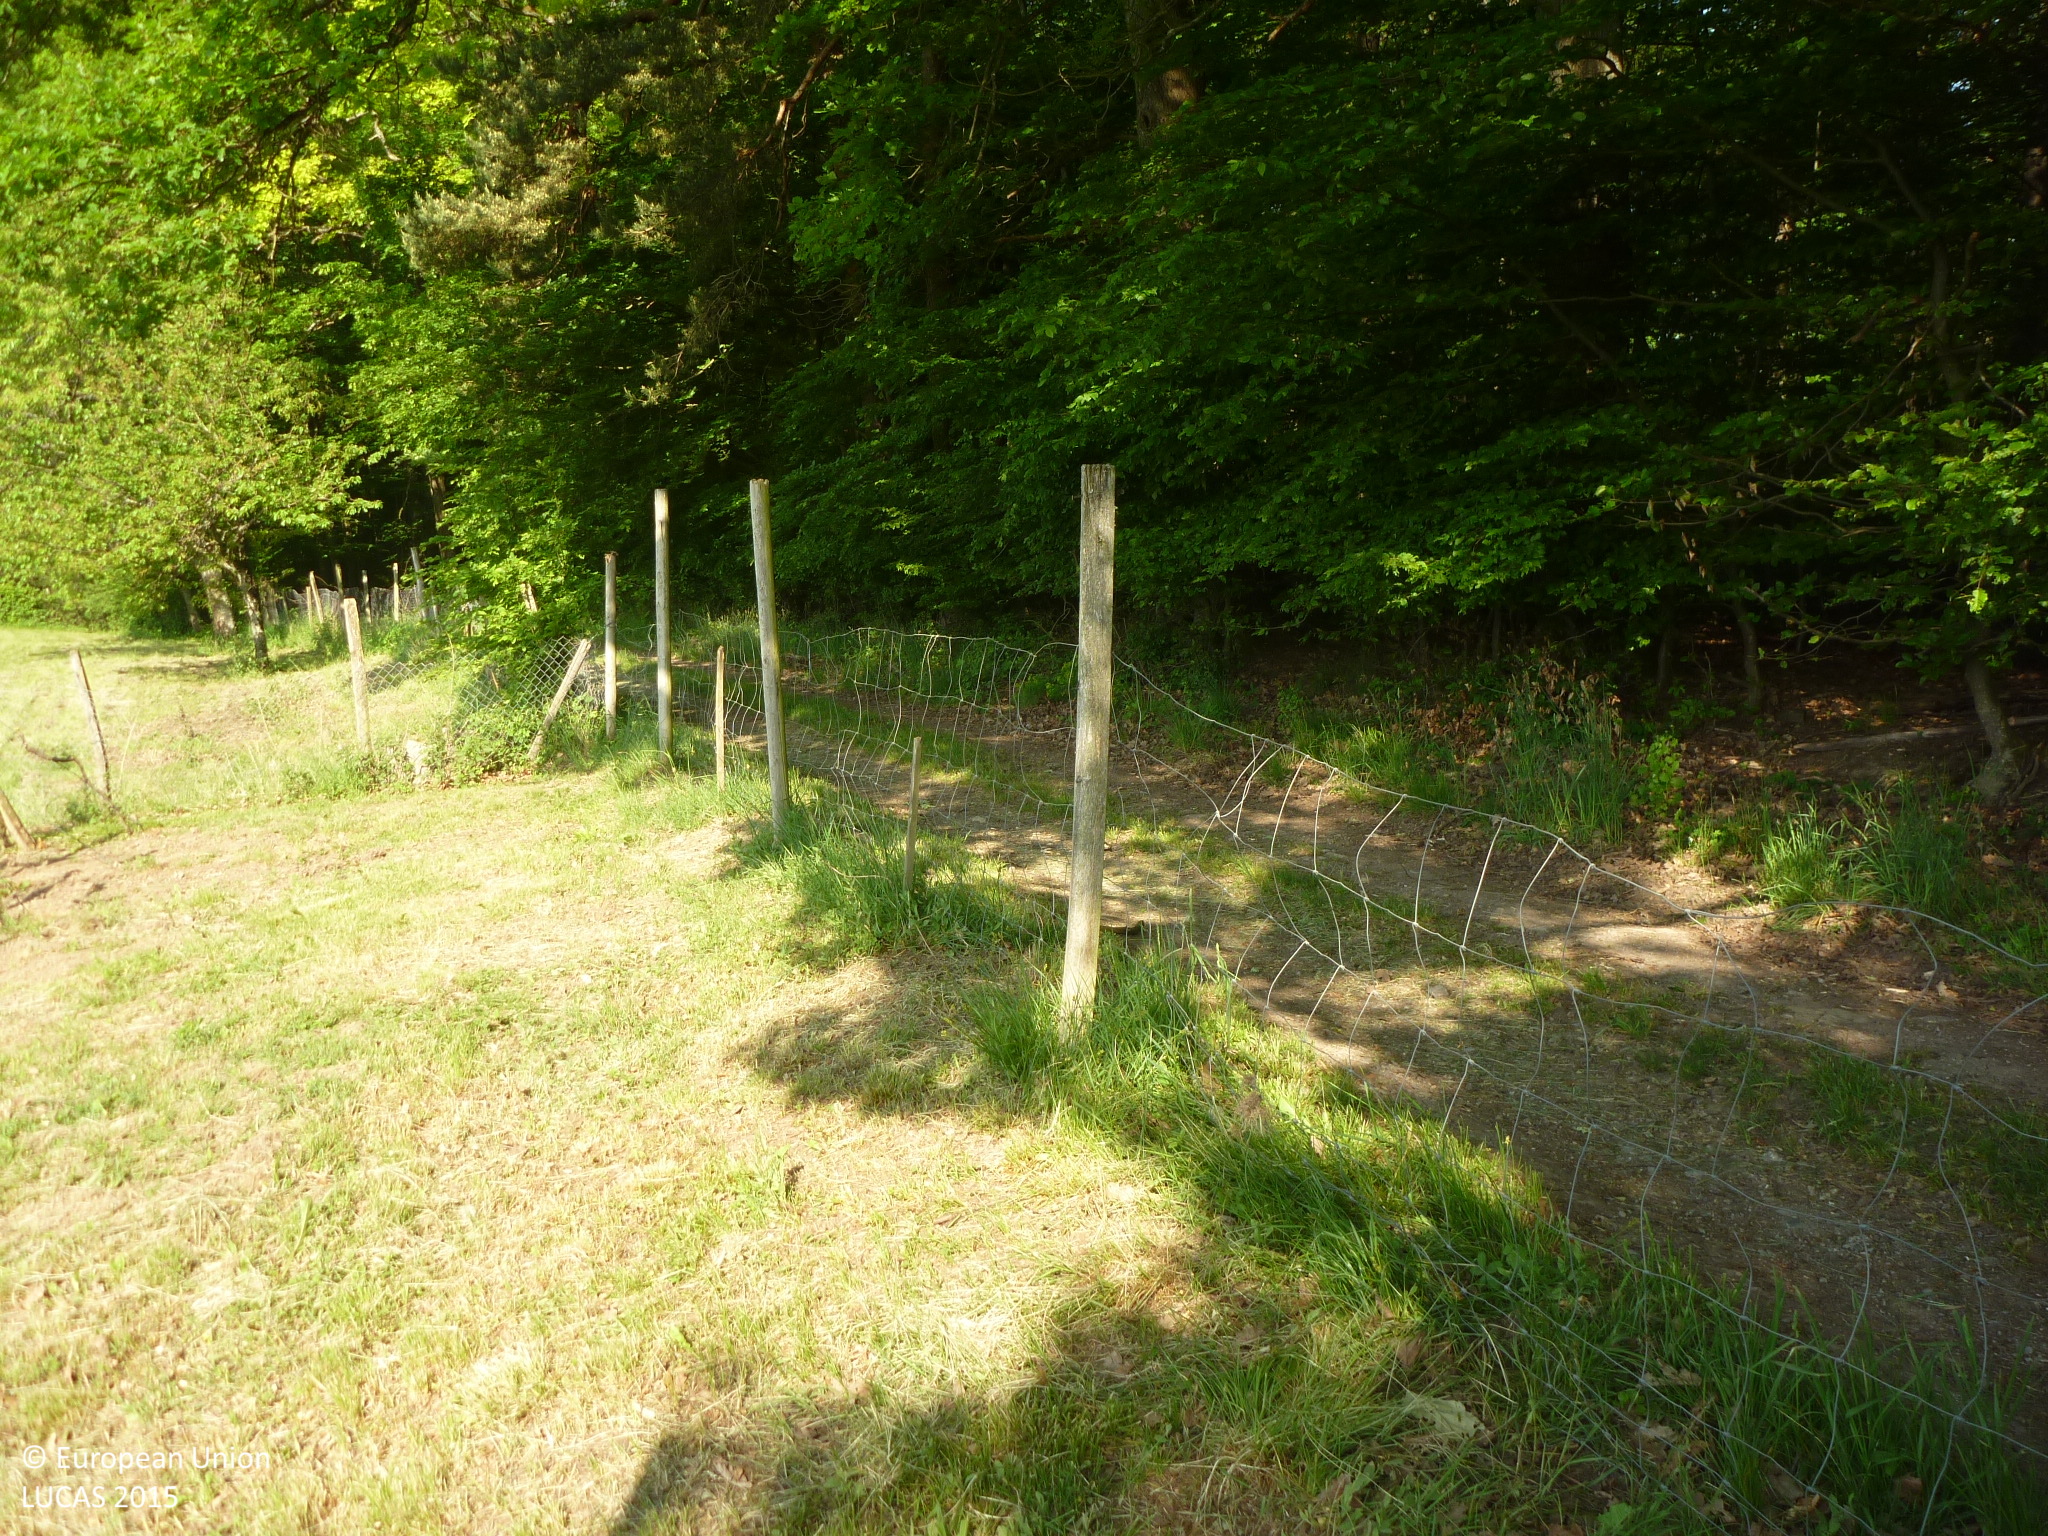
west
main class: Cropland
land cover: Vineyards
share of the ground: 25 - 50 %
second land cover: Grassland without tree/shrub cover
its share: > 75 %
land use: Agriculture (excluding fallow land and kitchen gardens)
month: May
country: DE
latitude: 49.1031
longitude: 9.3291
